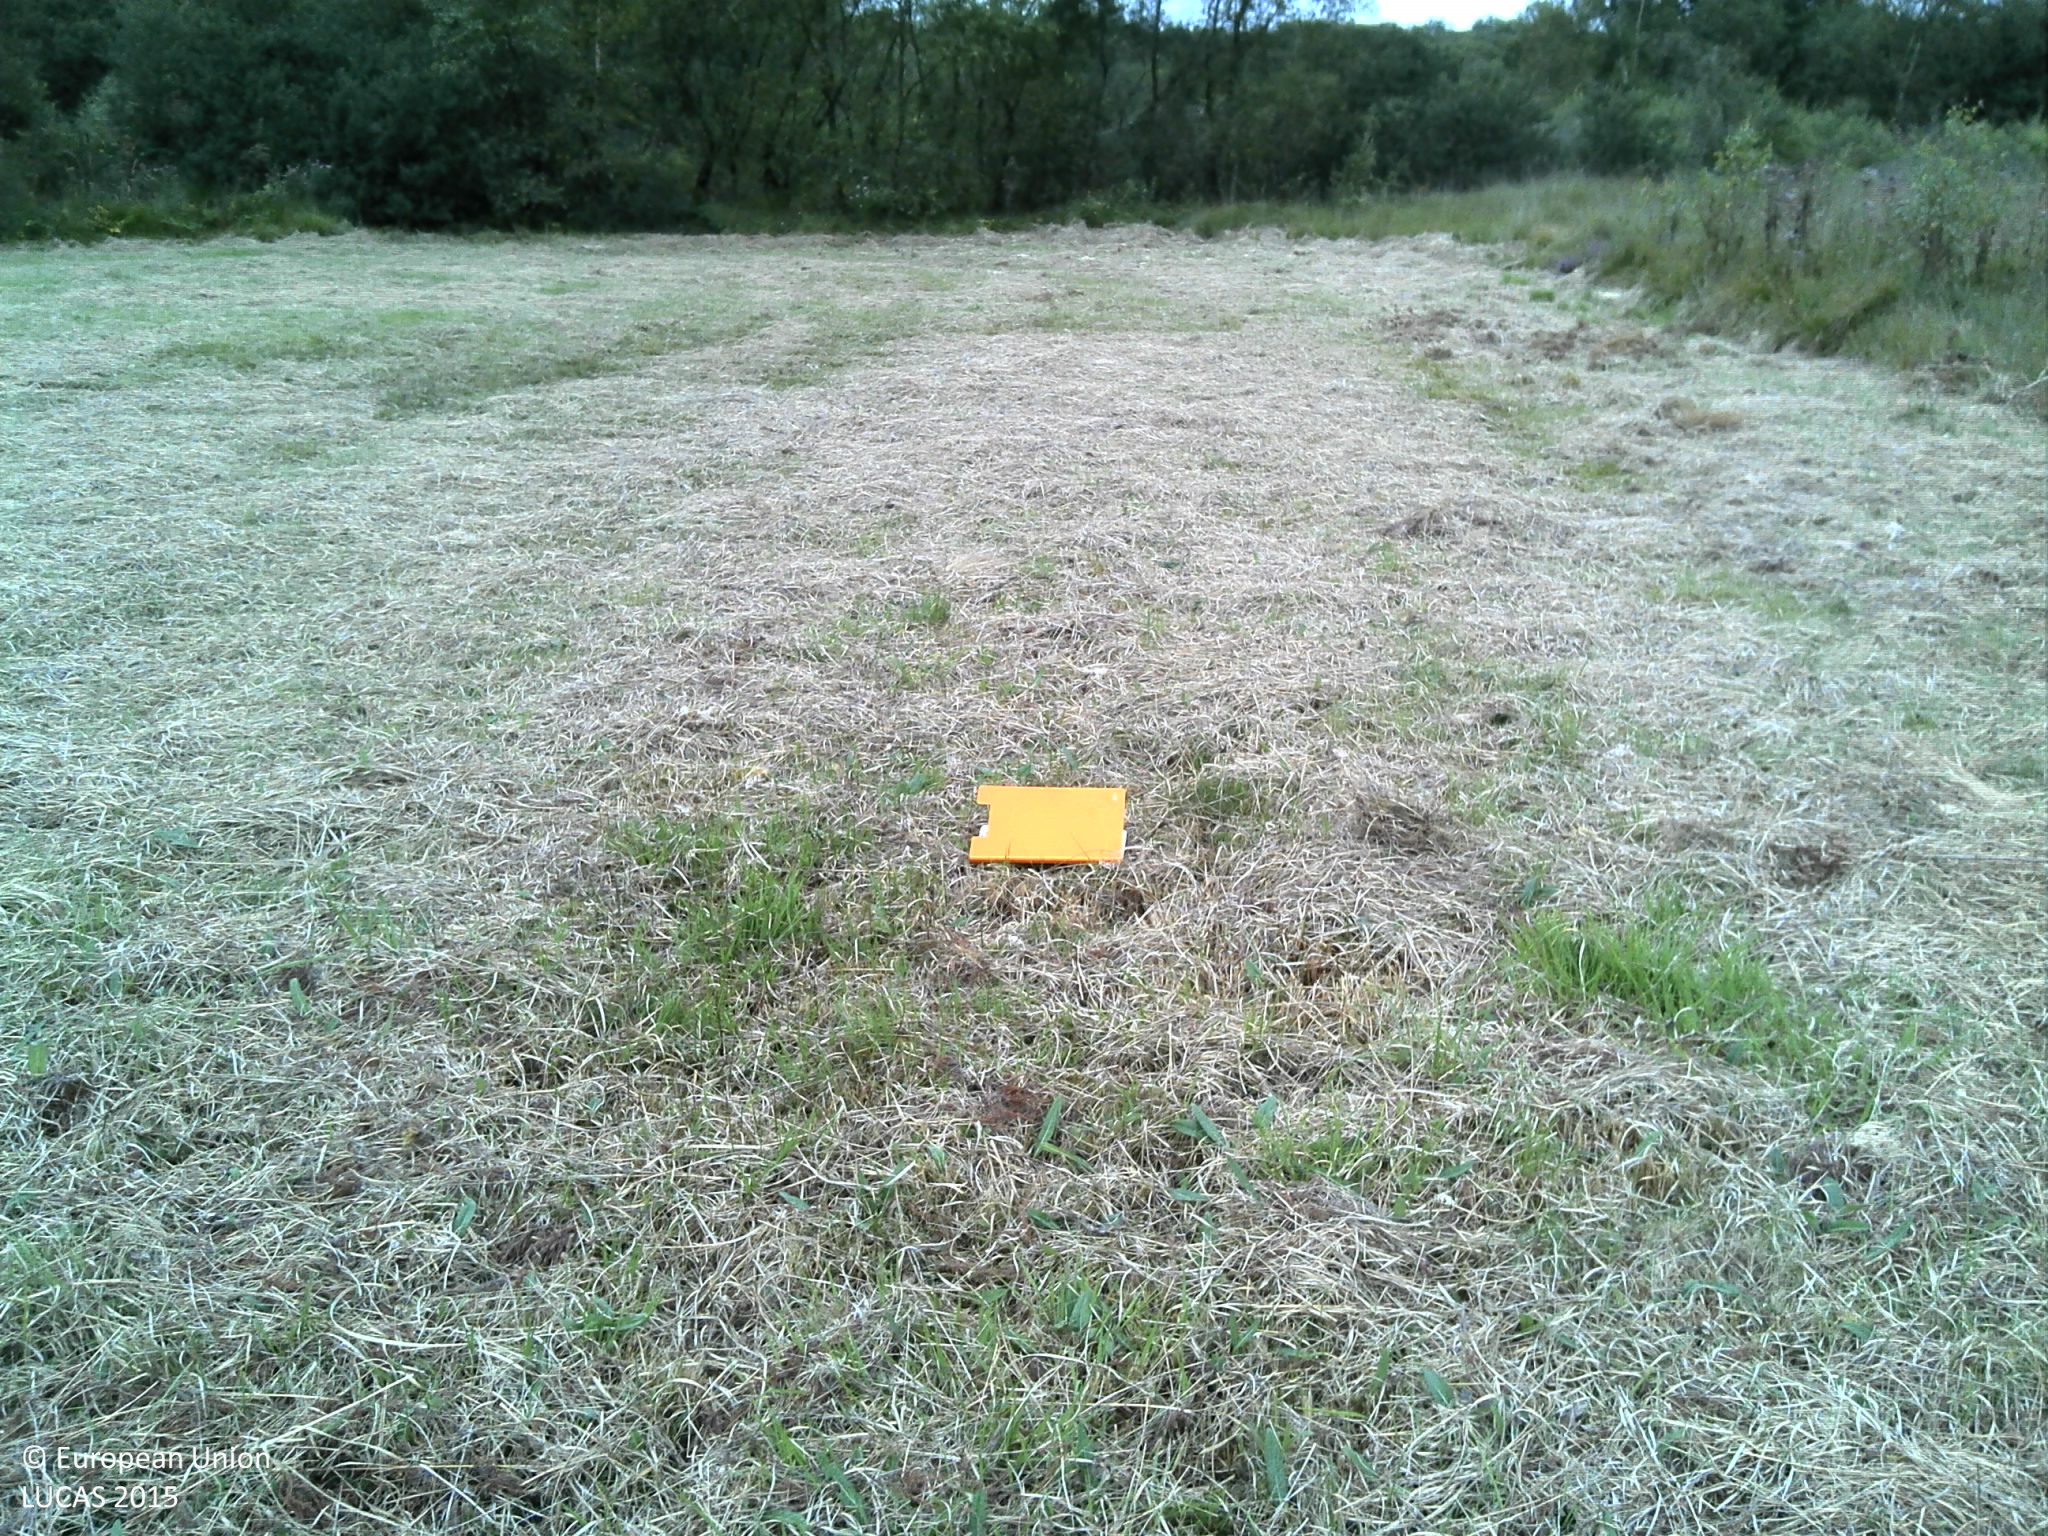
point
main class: Grassland
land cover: Grassland without tree/shrub cover
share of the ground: > 75 %
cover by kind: herbaceous plants 100 %
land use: Agriculture (excluding fallow land and kitchen gardens)
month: September
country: FR
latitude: 48.5136
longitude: -4.2678
